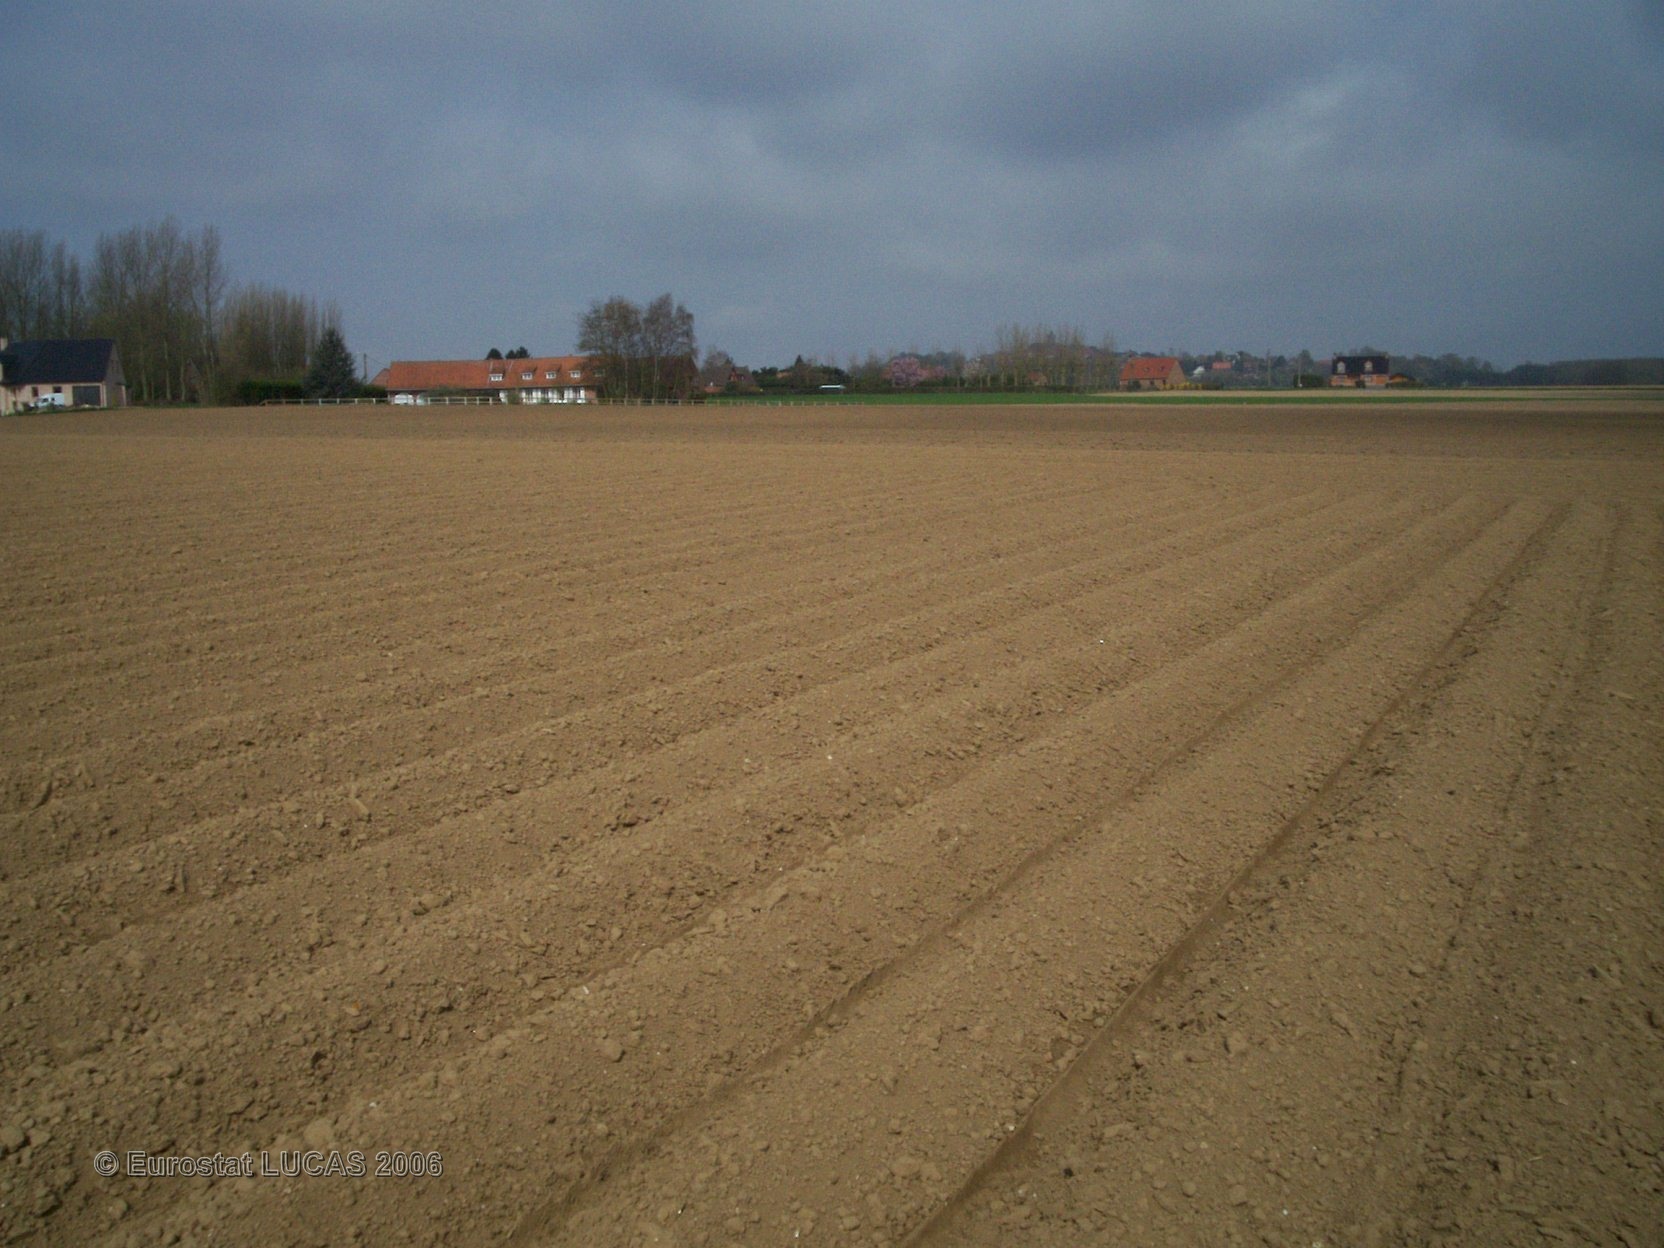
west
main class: Cropland
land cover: Potatoes
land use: Agriculture (excluding fallow land and kitchen gardens)
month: April
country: FR
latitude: 50.7866
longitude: 2.5120
